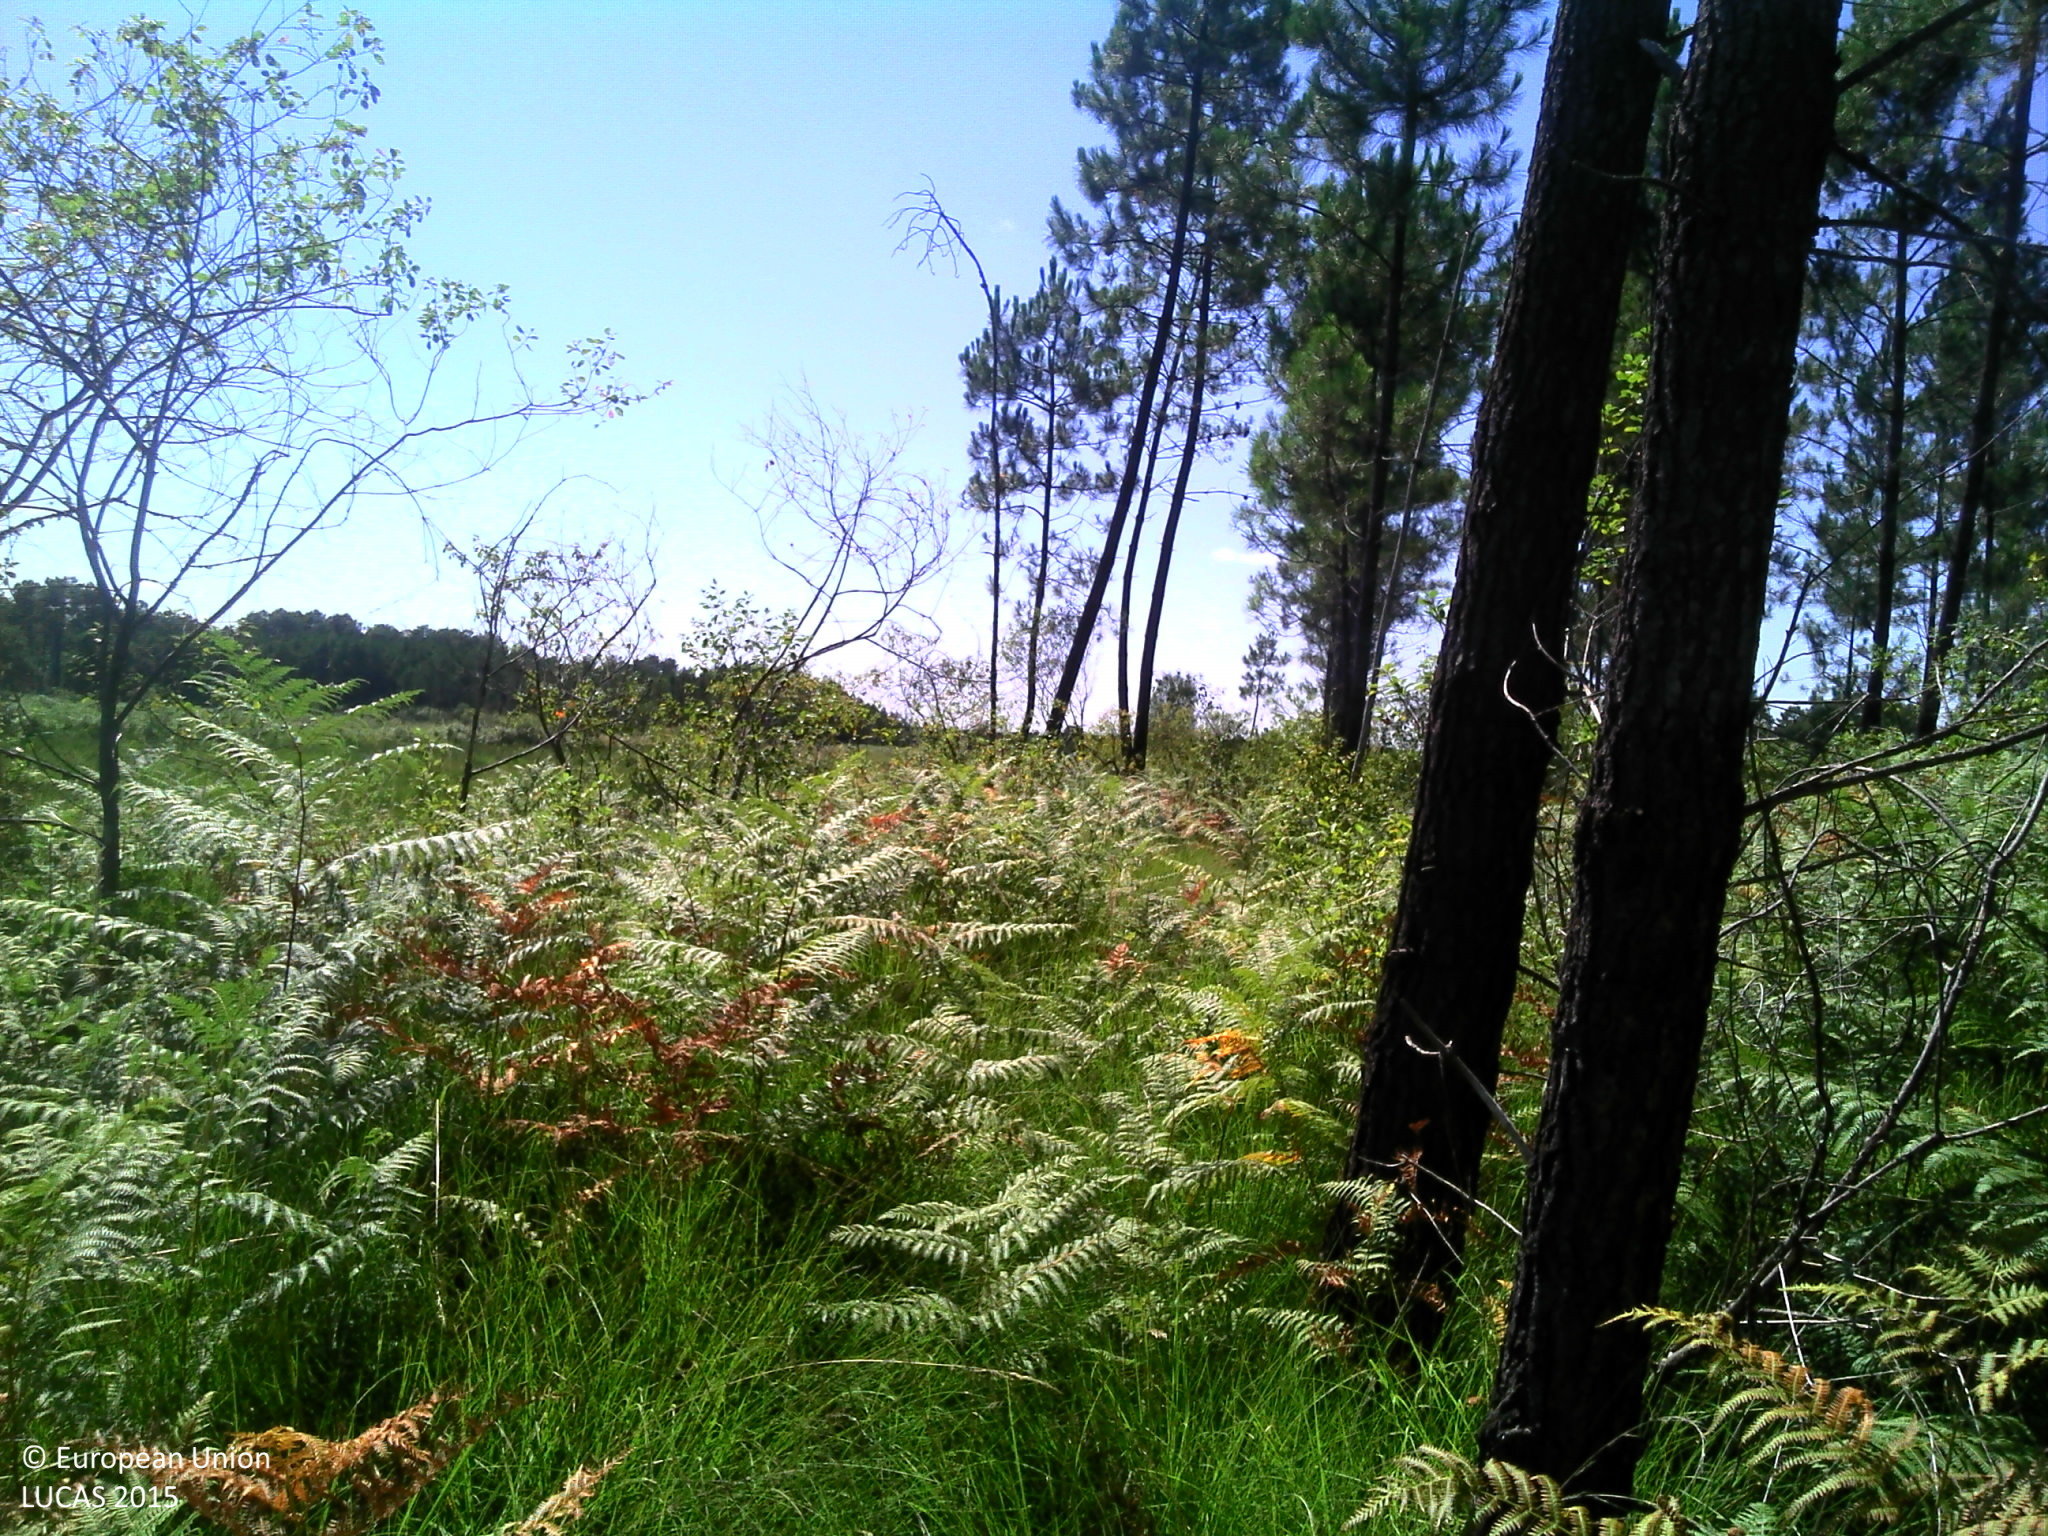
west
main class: Woodland
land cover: Pine dominated coniferous woodland
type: coniferous forest of the mediterranean region
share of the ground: > 75 %
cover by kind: coniferous forest trees 80 %, herbaceous plants 20 %
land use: Forestry
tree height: > 5 m
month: July
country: FR
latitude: 44.0033
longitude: -0.6270
